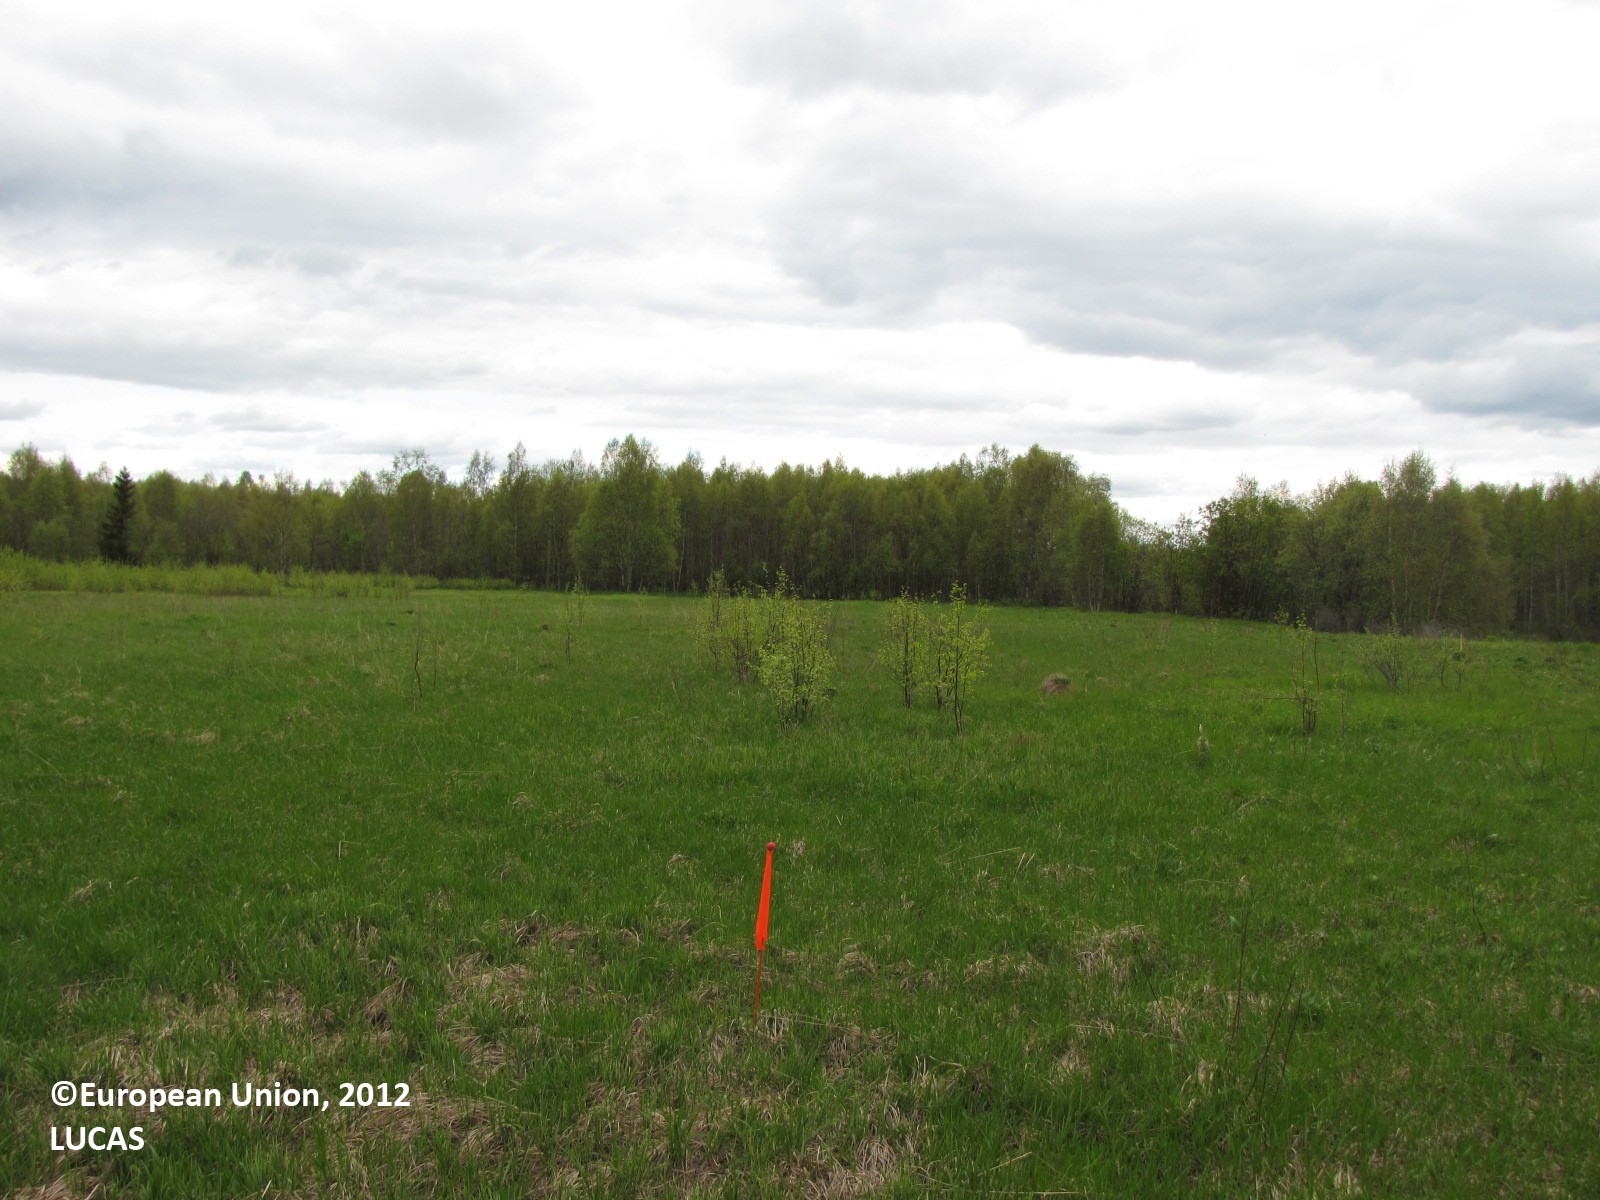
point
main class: Grassland
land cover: Grassland with sparse tree/shrub cover
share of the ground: > 75 %
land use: Agriculture (excluding fallow land and kitchen gardens)
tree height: < 5 m
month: June
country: FI
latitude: 65.7971
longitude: 24.4586
